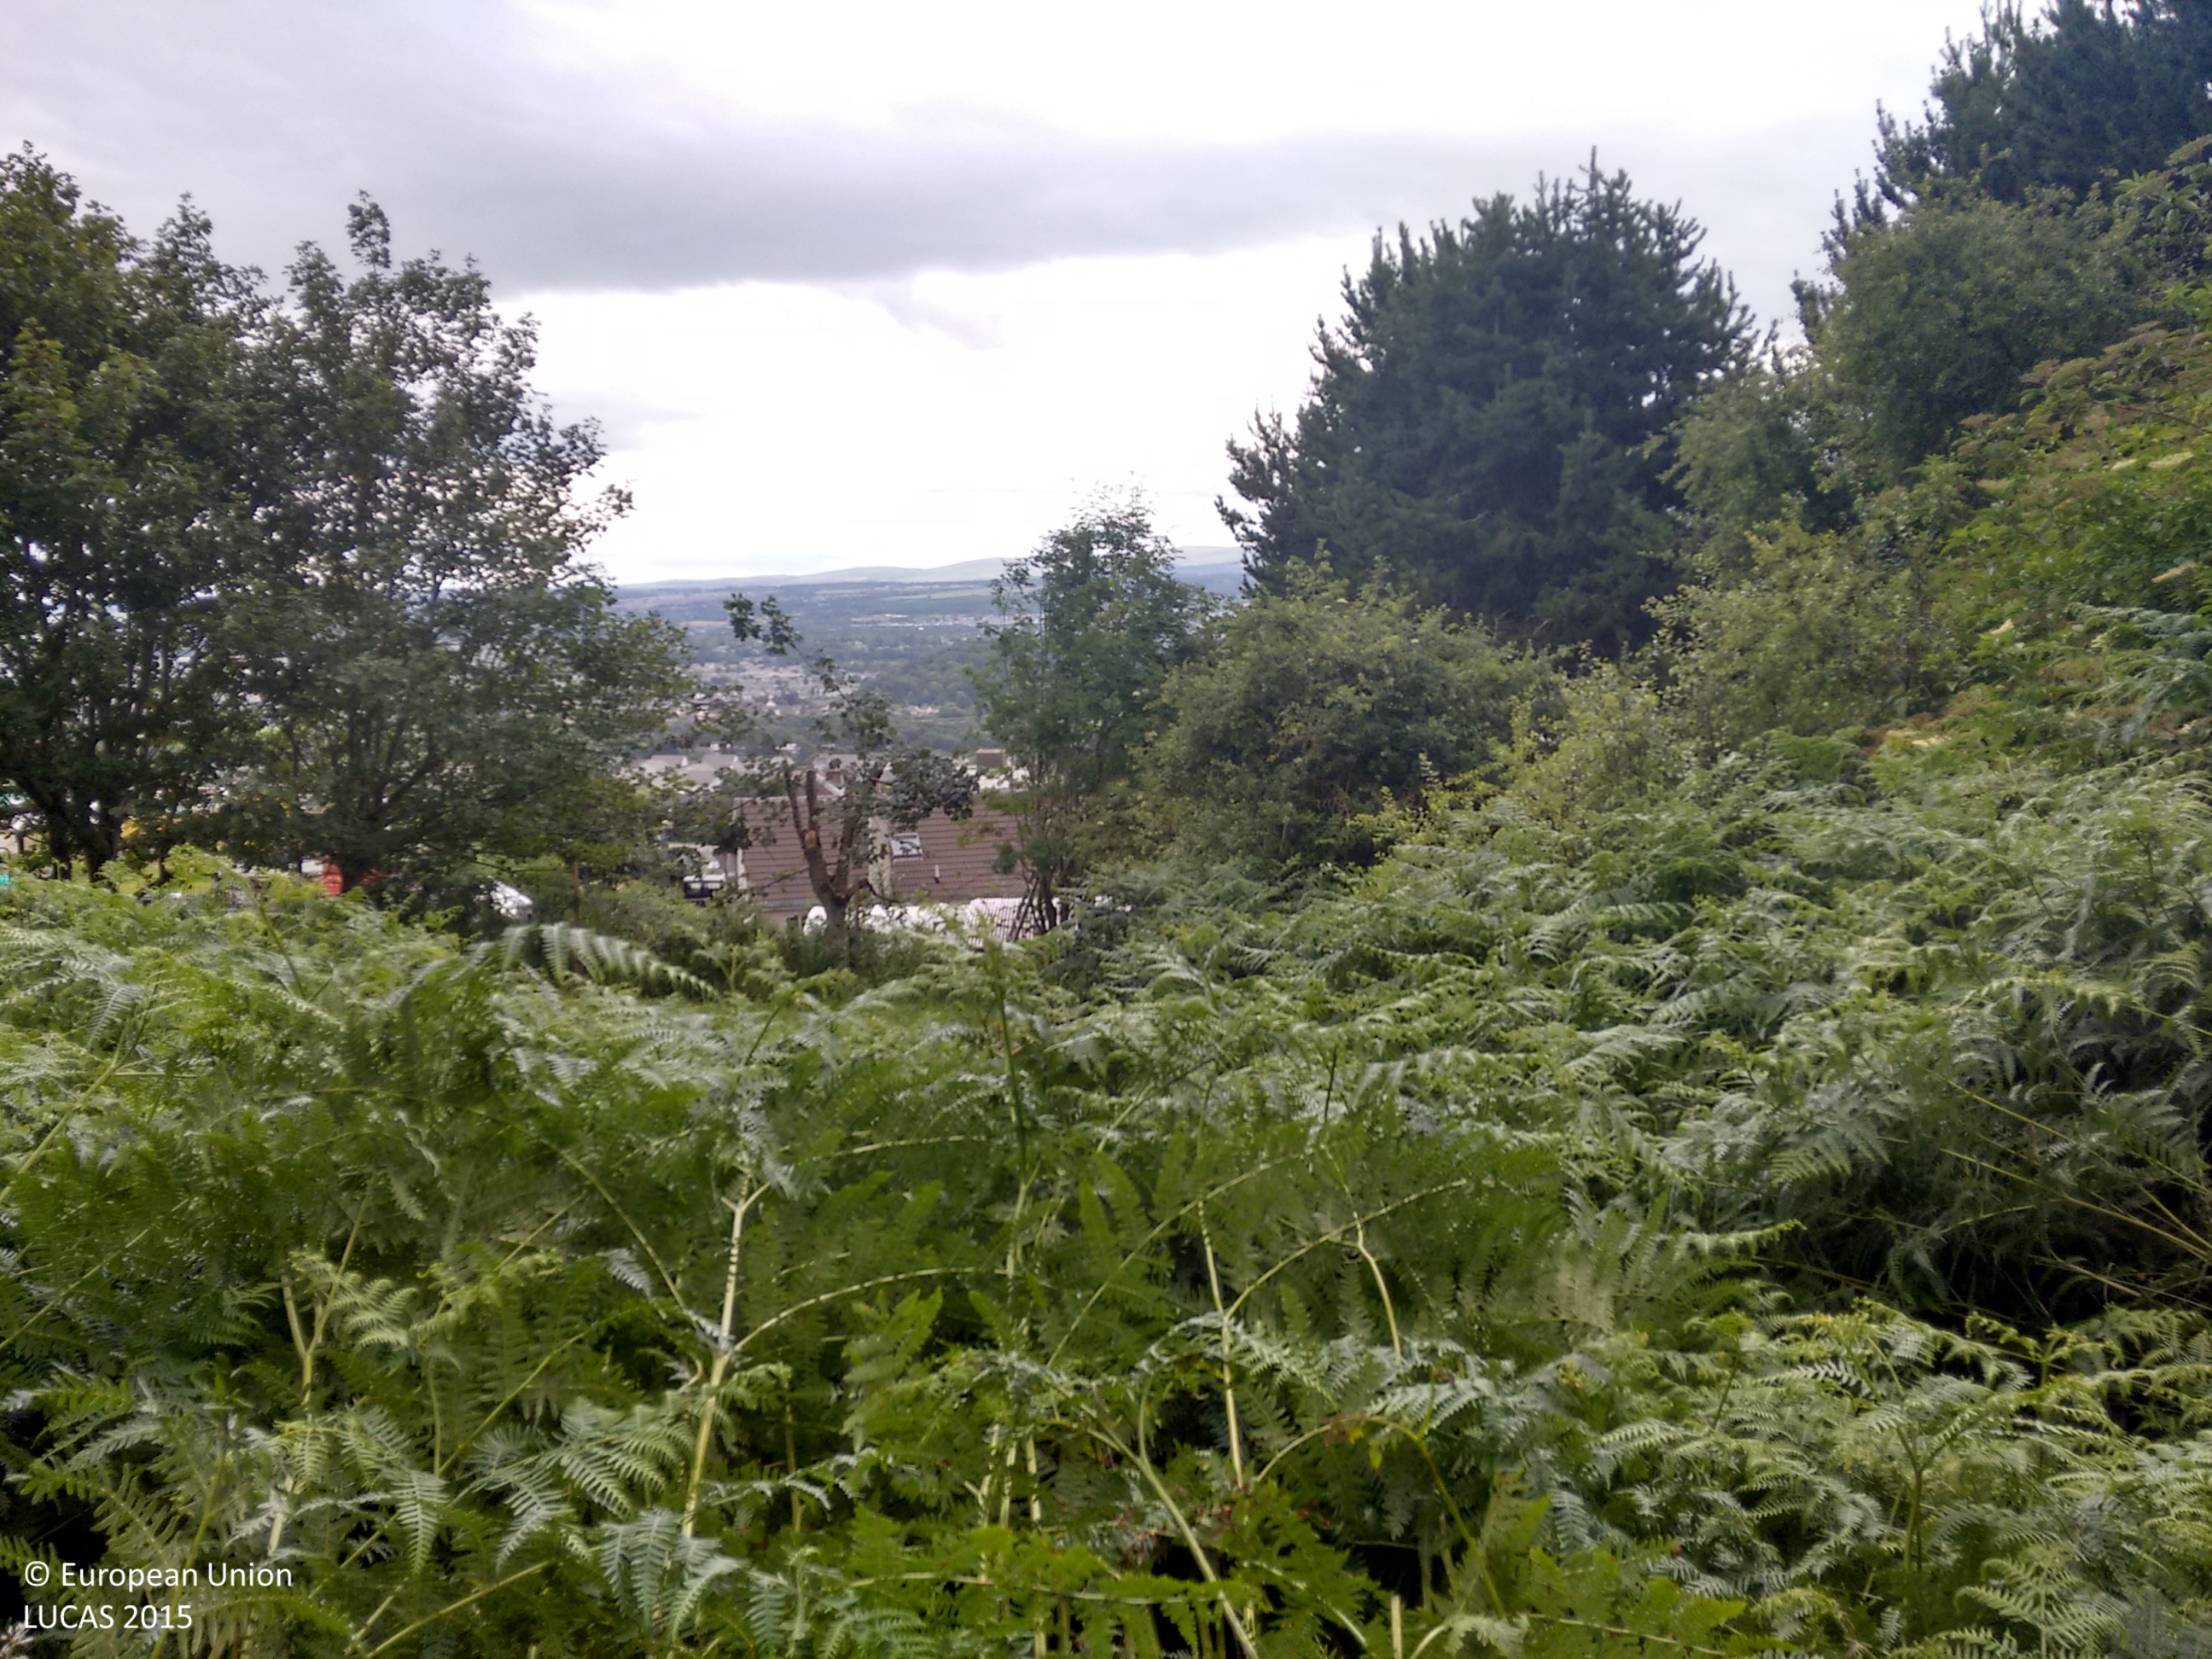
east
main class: Woodland
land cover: Other mixed woodland
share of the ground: > 75 %
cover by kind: coniferous forest trees 35 %, broadleaved forest trees 35 %, herbaceous plants 20 %, shrubs 10 %
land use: Residential
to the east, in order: Other mixed woodland; Artificial constructions in urban areas; Grassland without tree/shrub cover; Fences; Grassland without tree/shrub cover
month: August
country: GB
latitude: 57.4701
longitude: -4.2755
